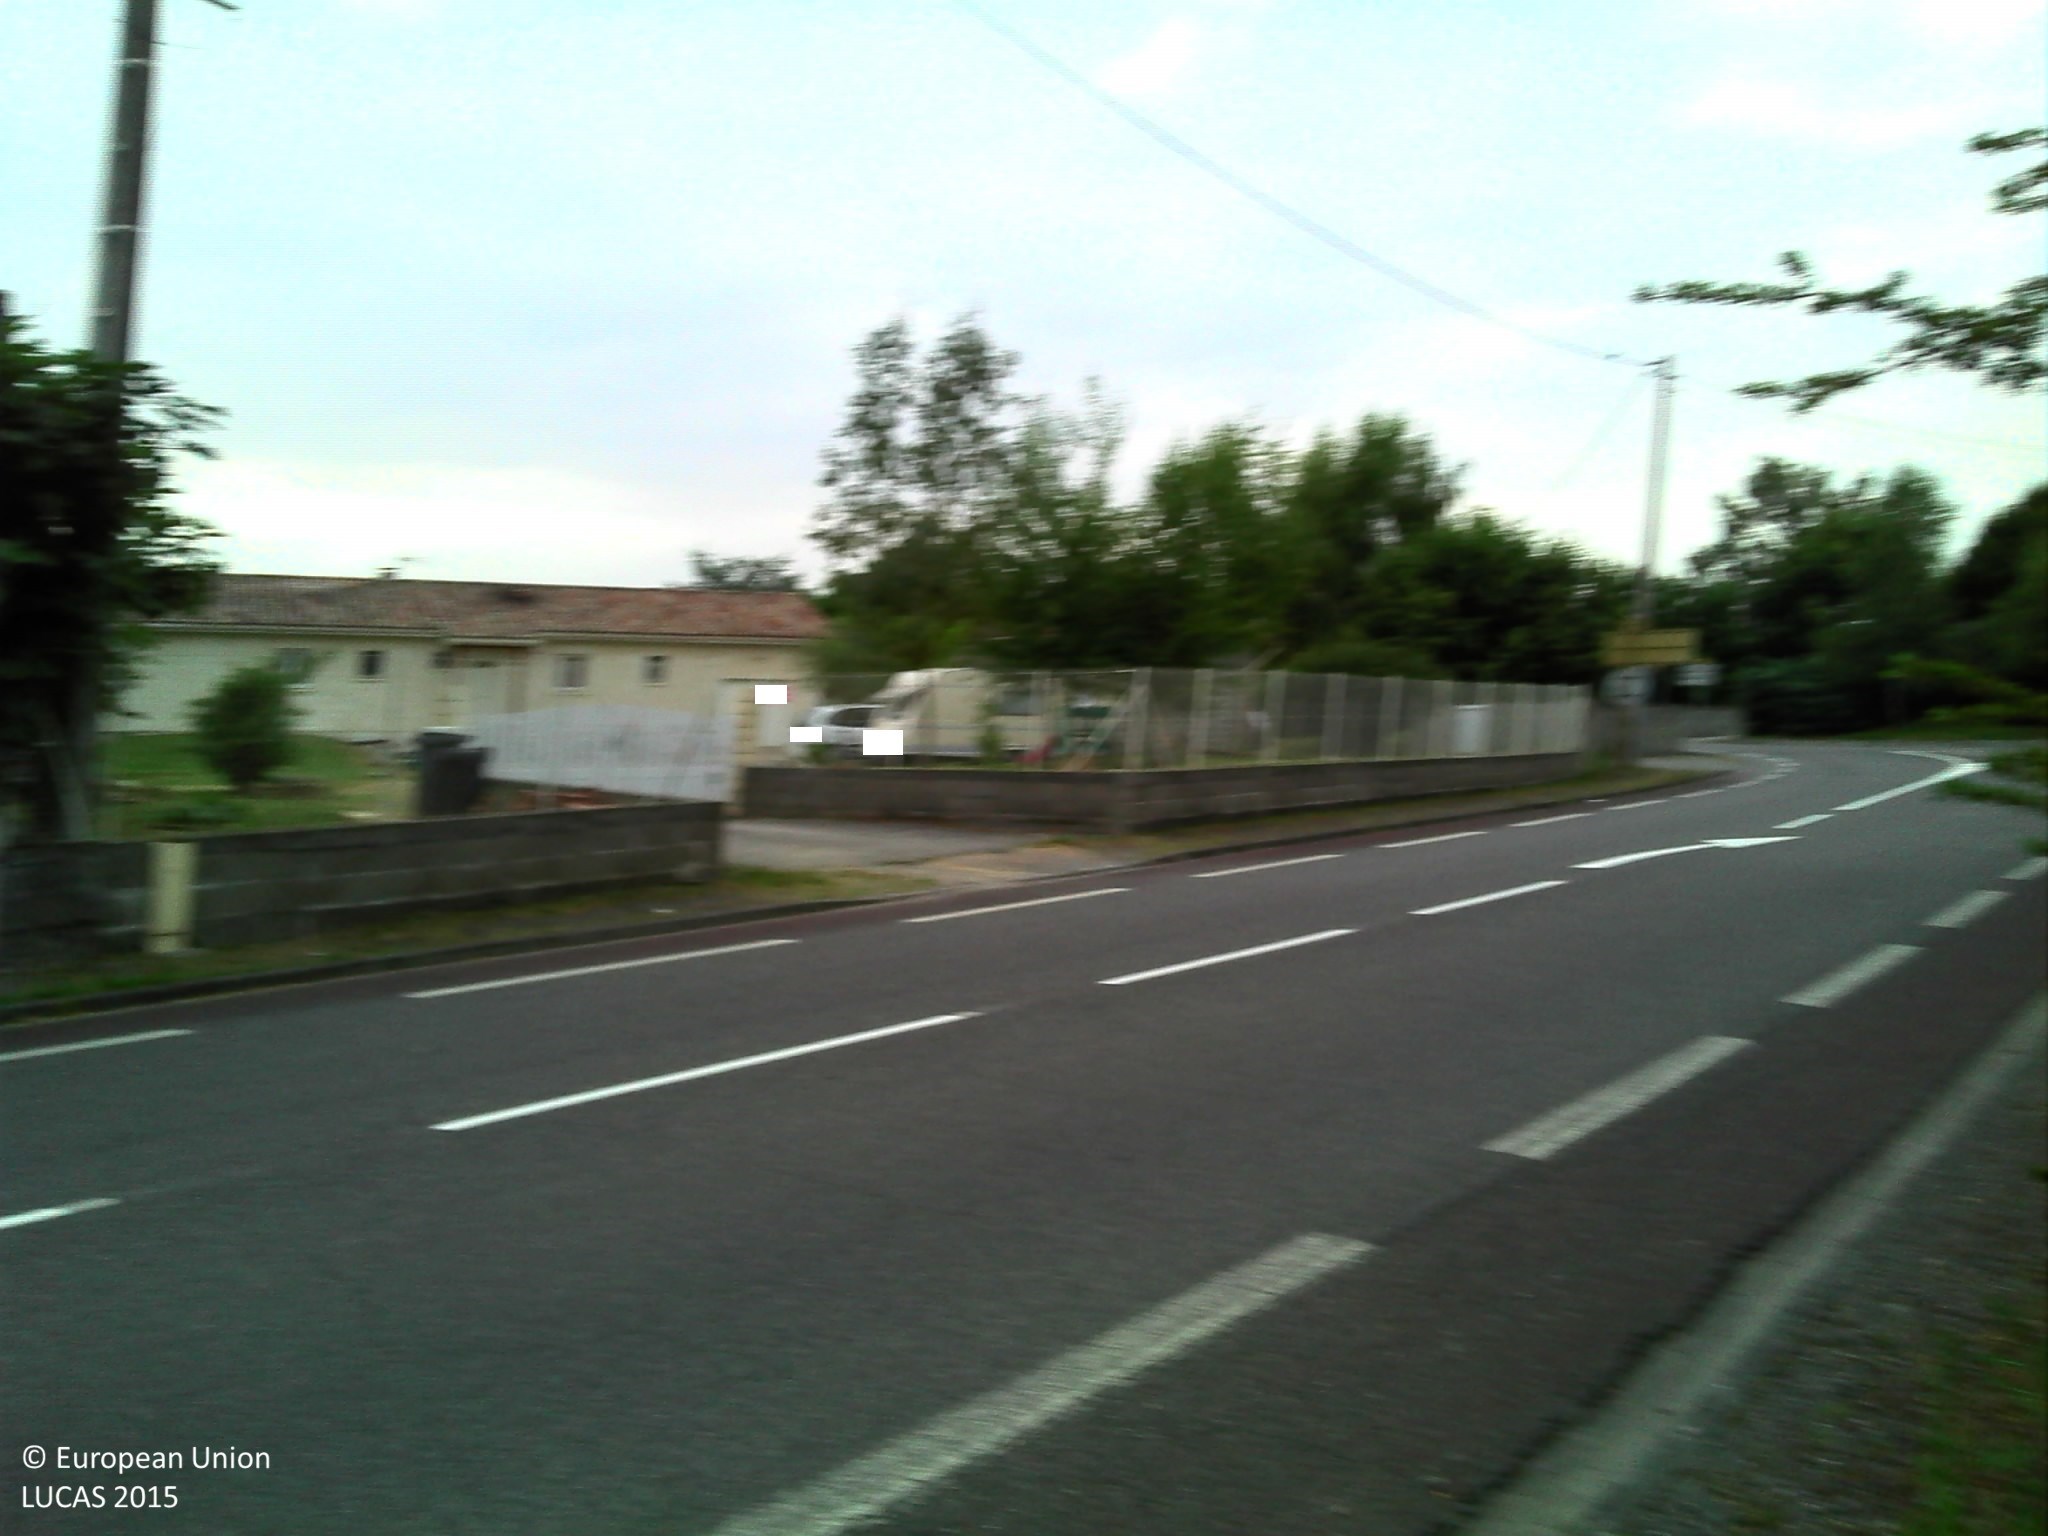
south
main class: Woodland
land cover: Spruce dominated mixed woodland
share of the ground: > 75 %
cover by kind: broadleaved forest trees 50 %, coniferous forest trees 30 %, shrubs 10 %, herbaceous plants 10 %
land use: Residential
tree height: > 5 m
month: July
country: FR
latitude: 43.1218
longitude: 0.7715
